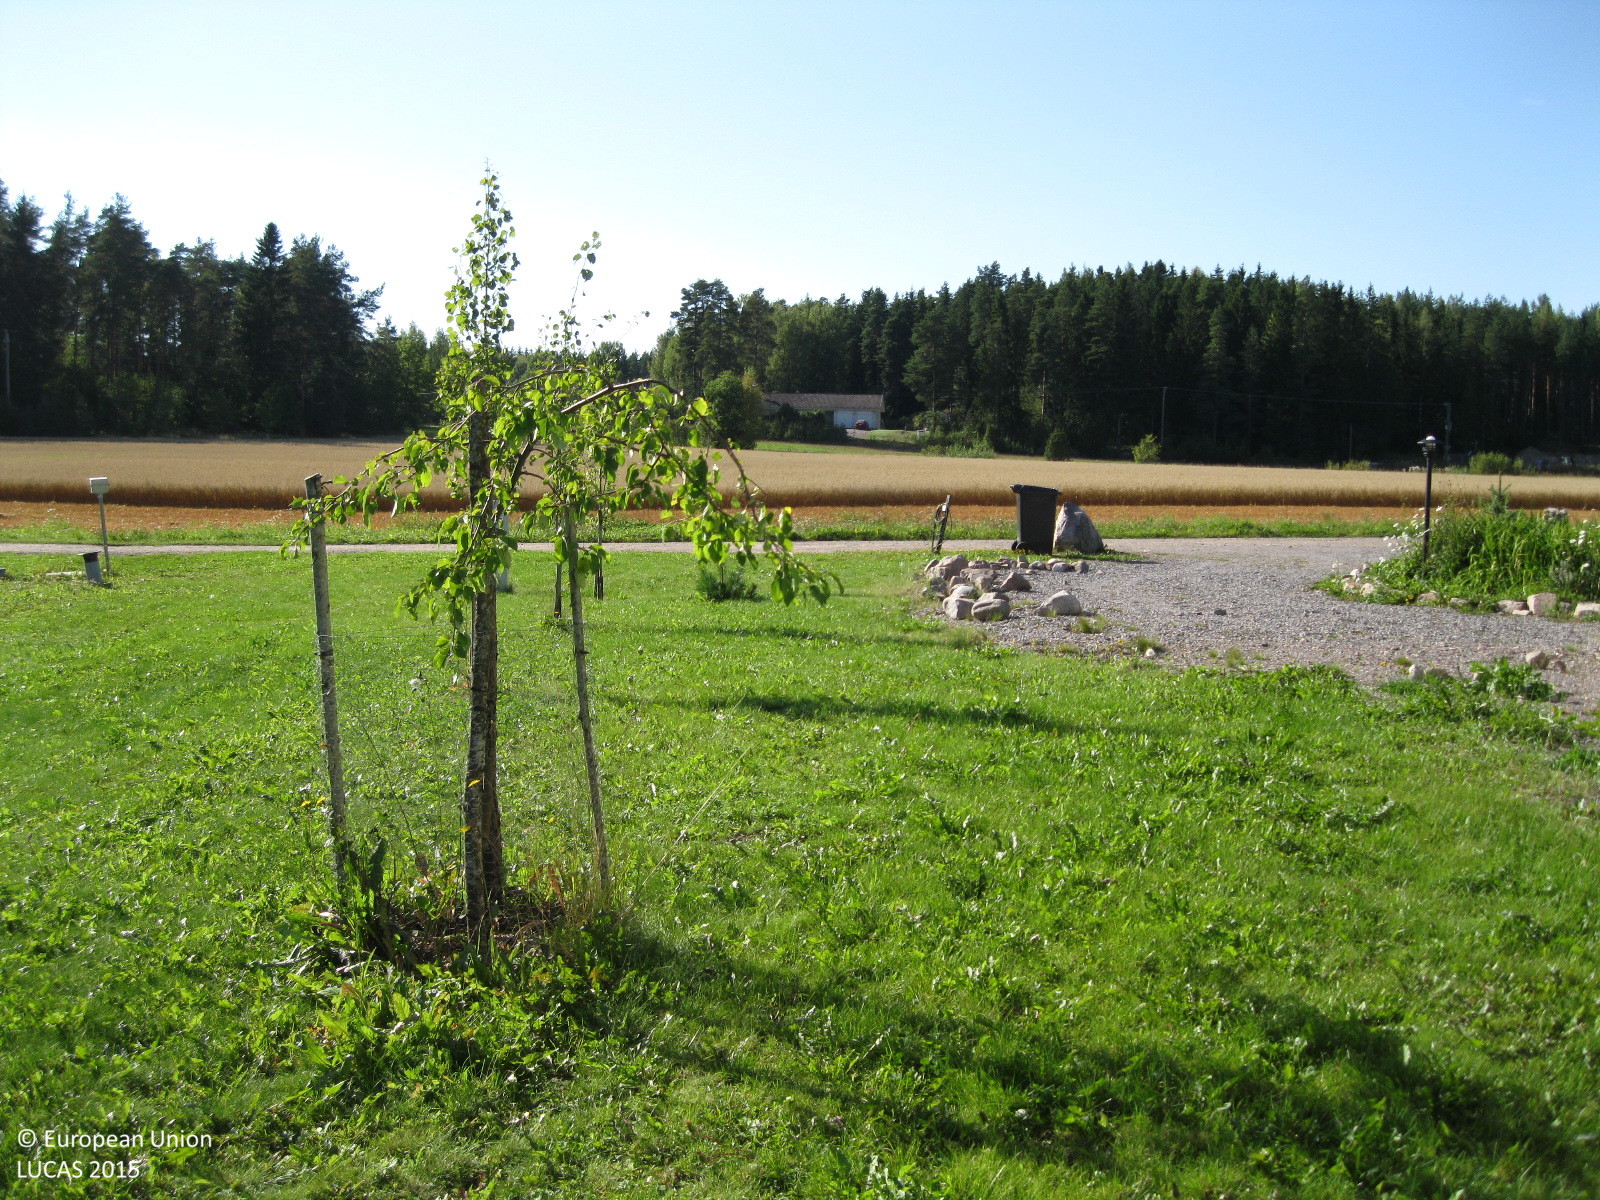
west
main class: Grassland
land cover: Grassland with sparse tree/shrub cover
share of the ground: > 75 %
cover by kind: herbaceous plants 95 %, coniferous forest trees 5 %
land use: Residential
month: September
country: FI
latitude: 60.6595
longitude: 24.9901
